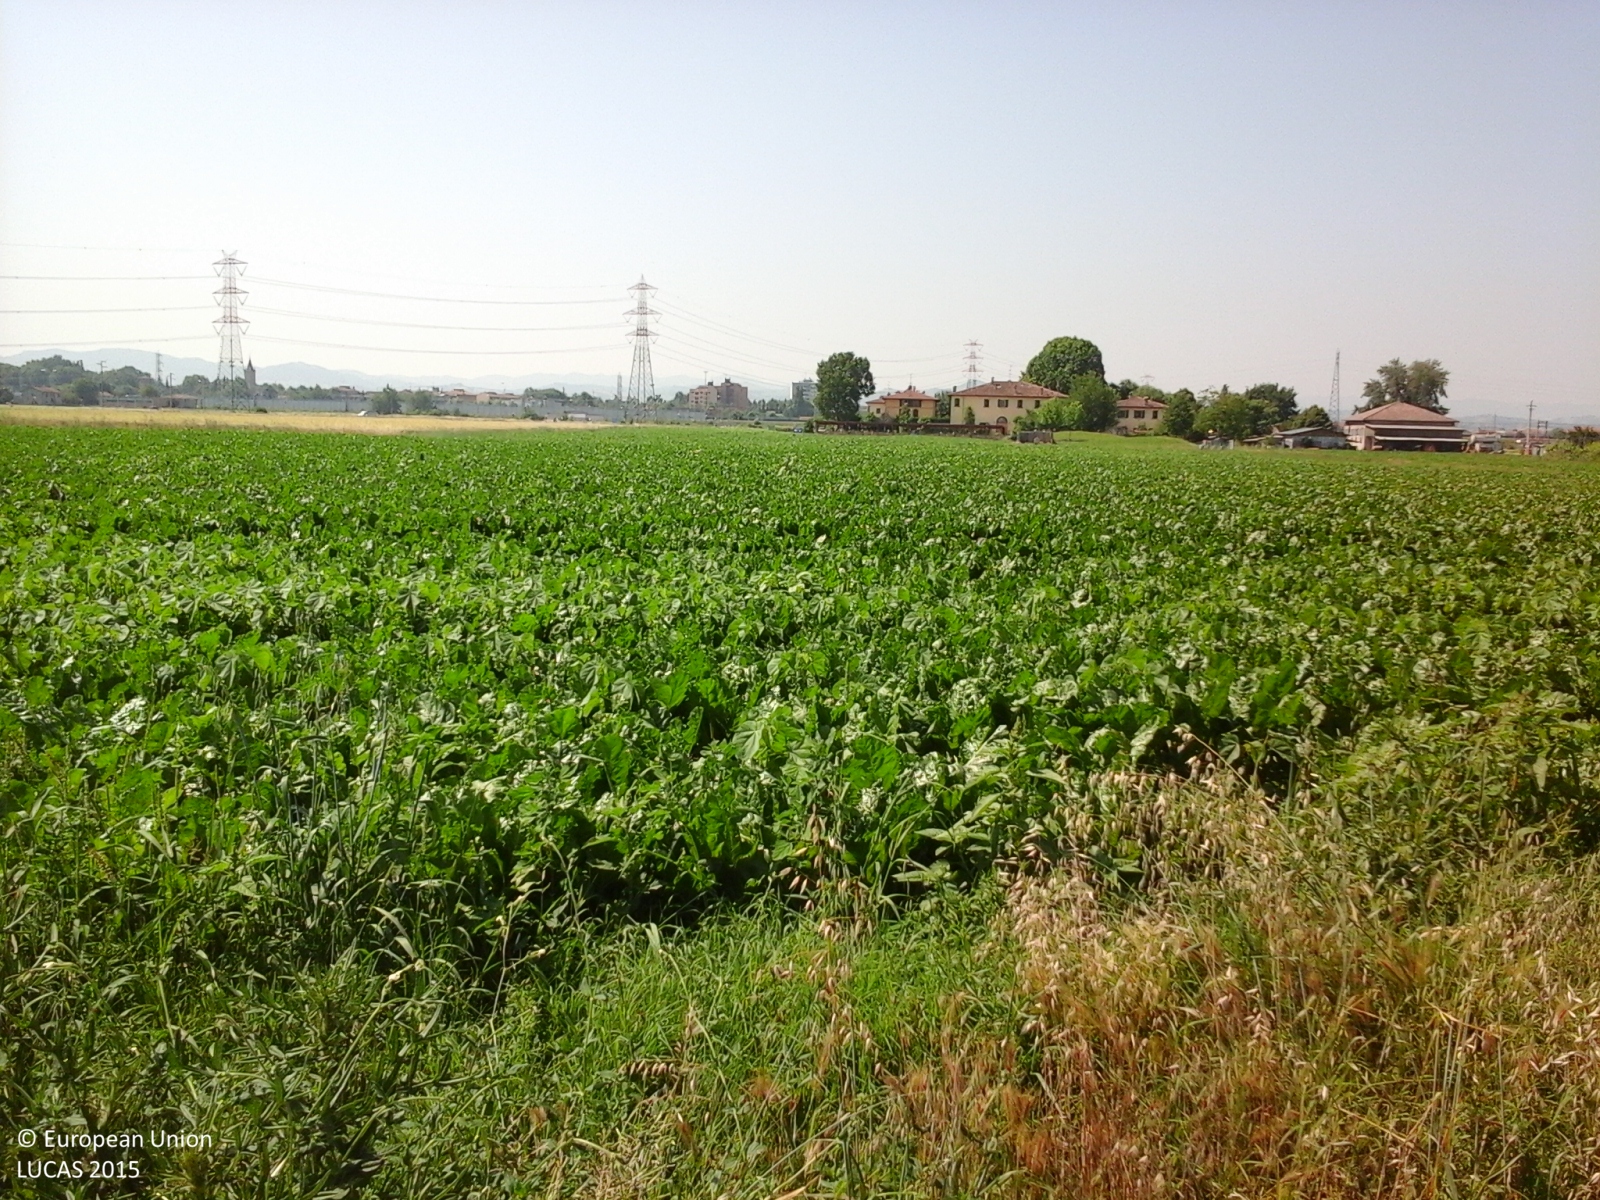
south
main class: Grassland
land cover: Grassland without tree/shrub cover
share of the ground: > 75 %
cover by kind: herbaceous plants 100 %
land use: Residential
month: June
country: IT
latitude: 44.5601
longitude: 11.1935
